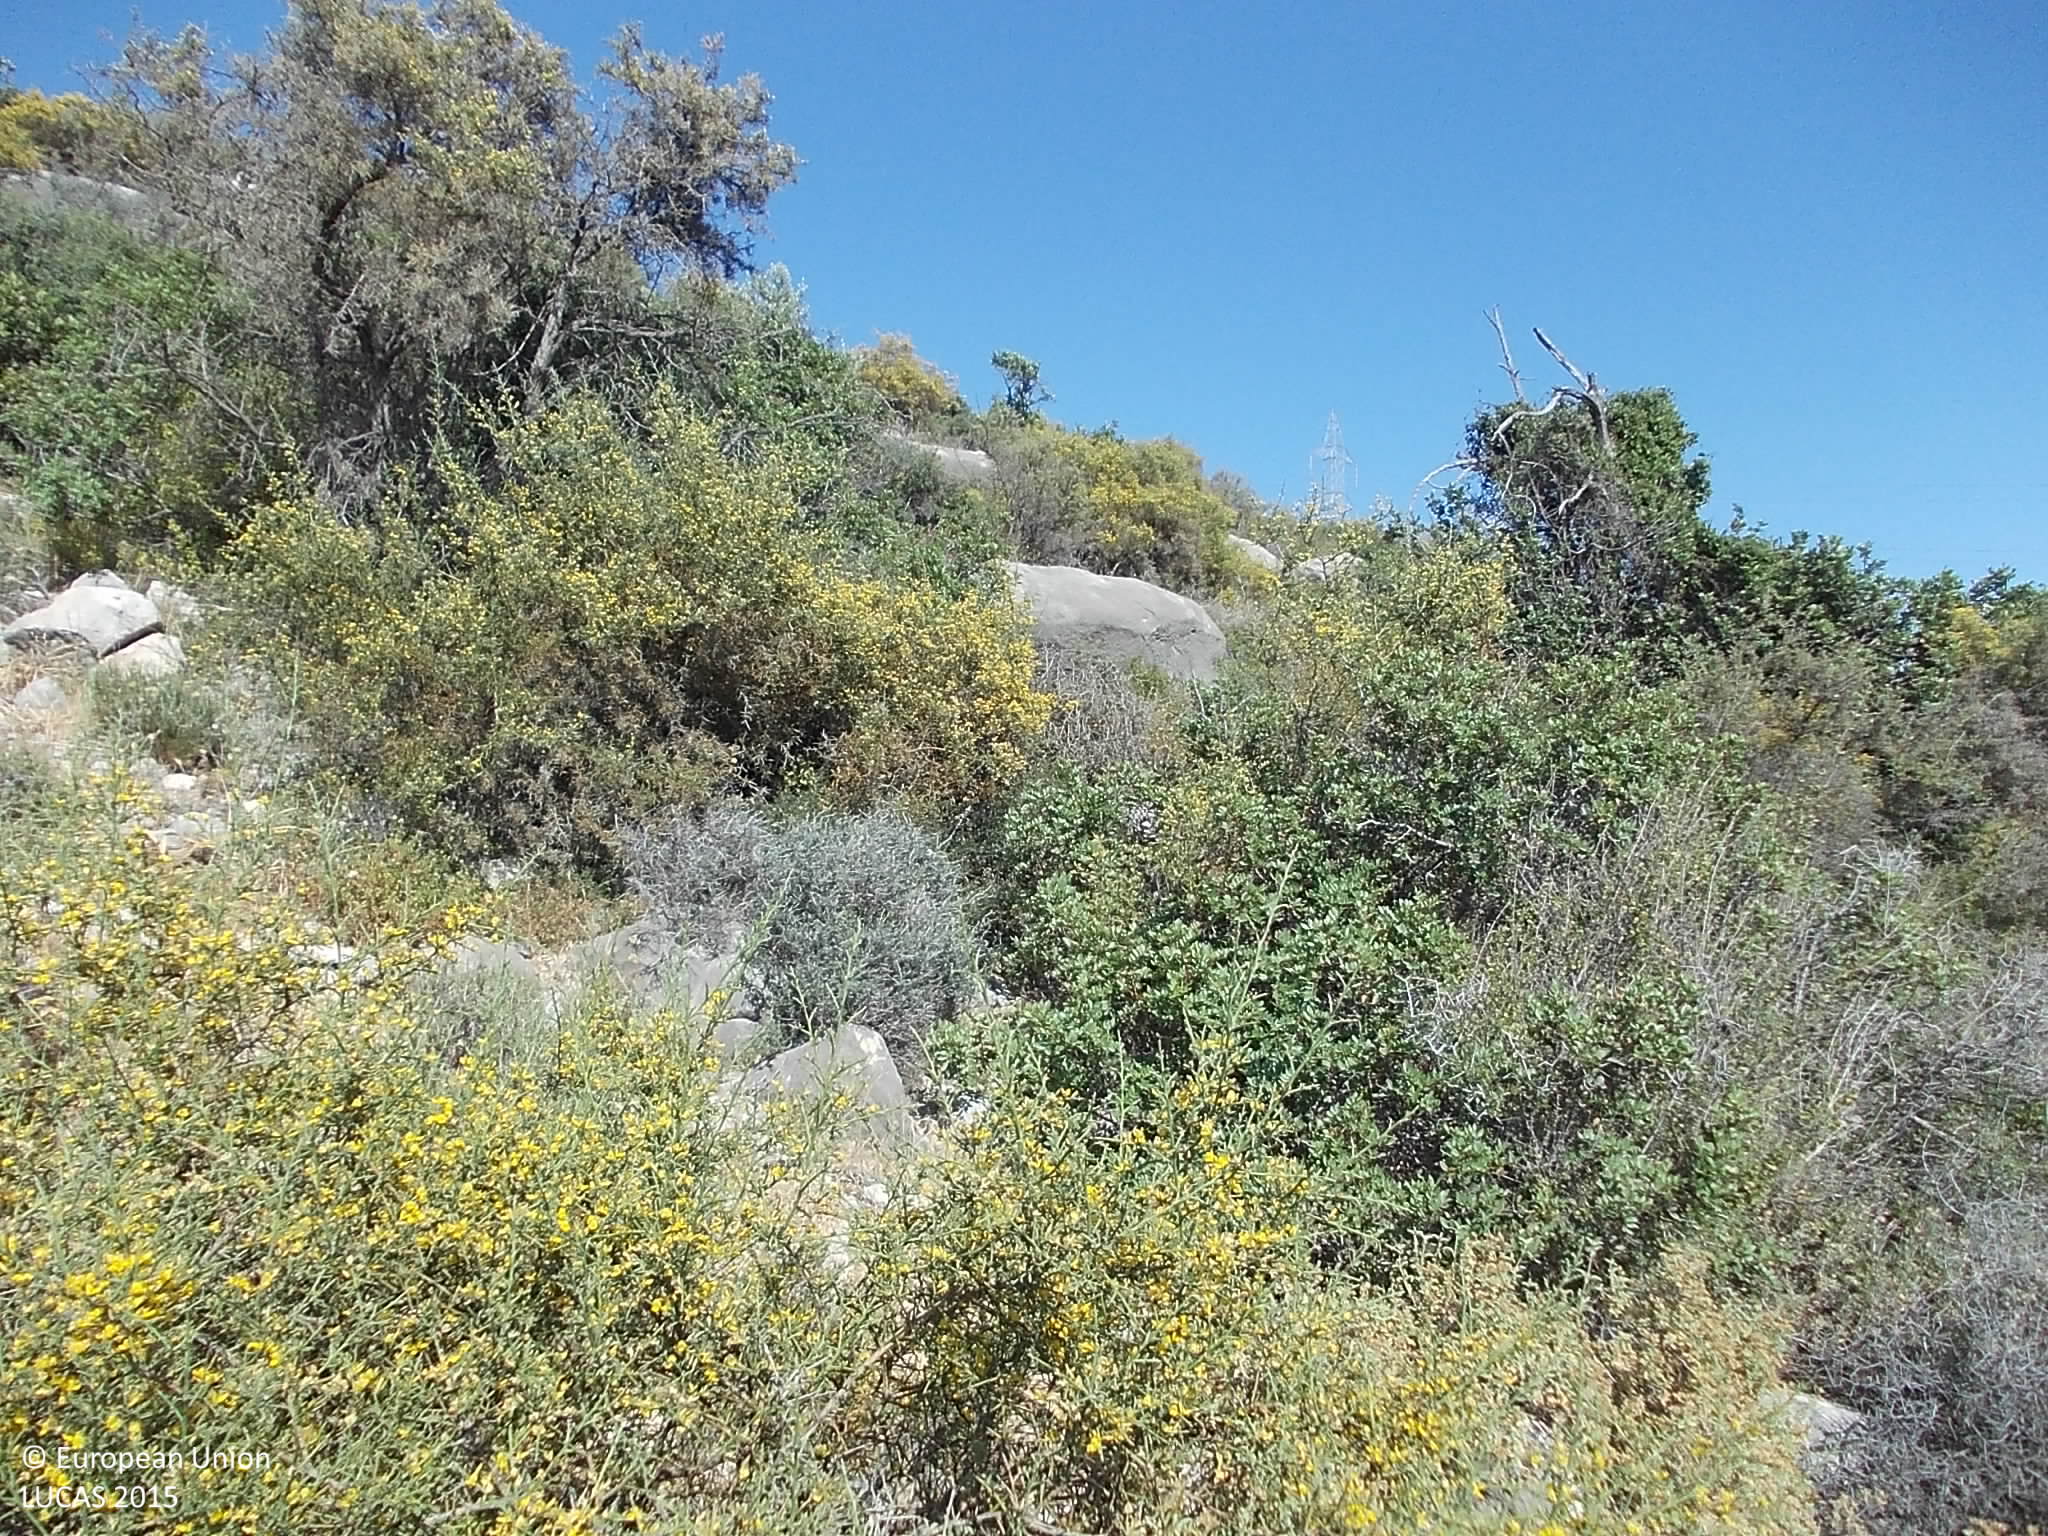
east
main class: Shrubland
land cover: Shrubland with sparse tree cover
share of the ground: > 75 %
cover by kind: shrubs 75 %, unconsolidated bare surface 20 %, broadleaved forest trees 5 %
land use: Semi-natural and natural areas not in use
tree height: < 5 m
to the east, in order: Shrubland with sparse tree cover; Tracks; Shrubland without tree cover; Rock outcrops; Shrubland without tree cover; Grassland without tree/shrub cover; Shrubland without tree cover; Electric lines
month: May
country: CY
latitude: 34.7197
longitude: 32.9973
